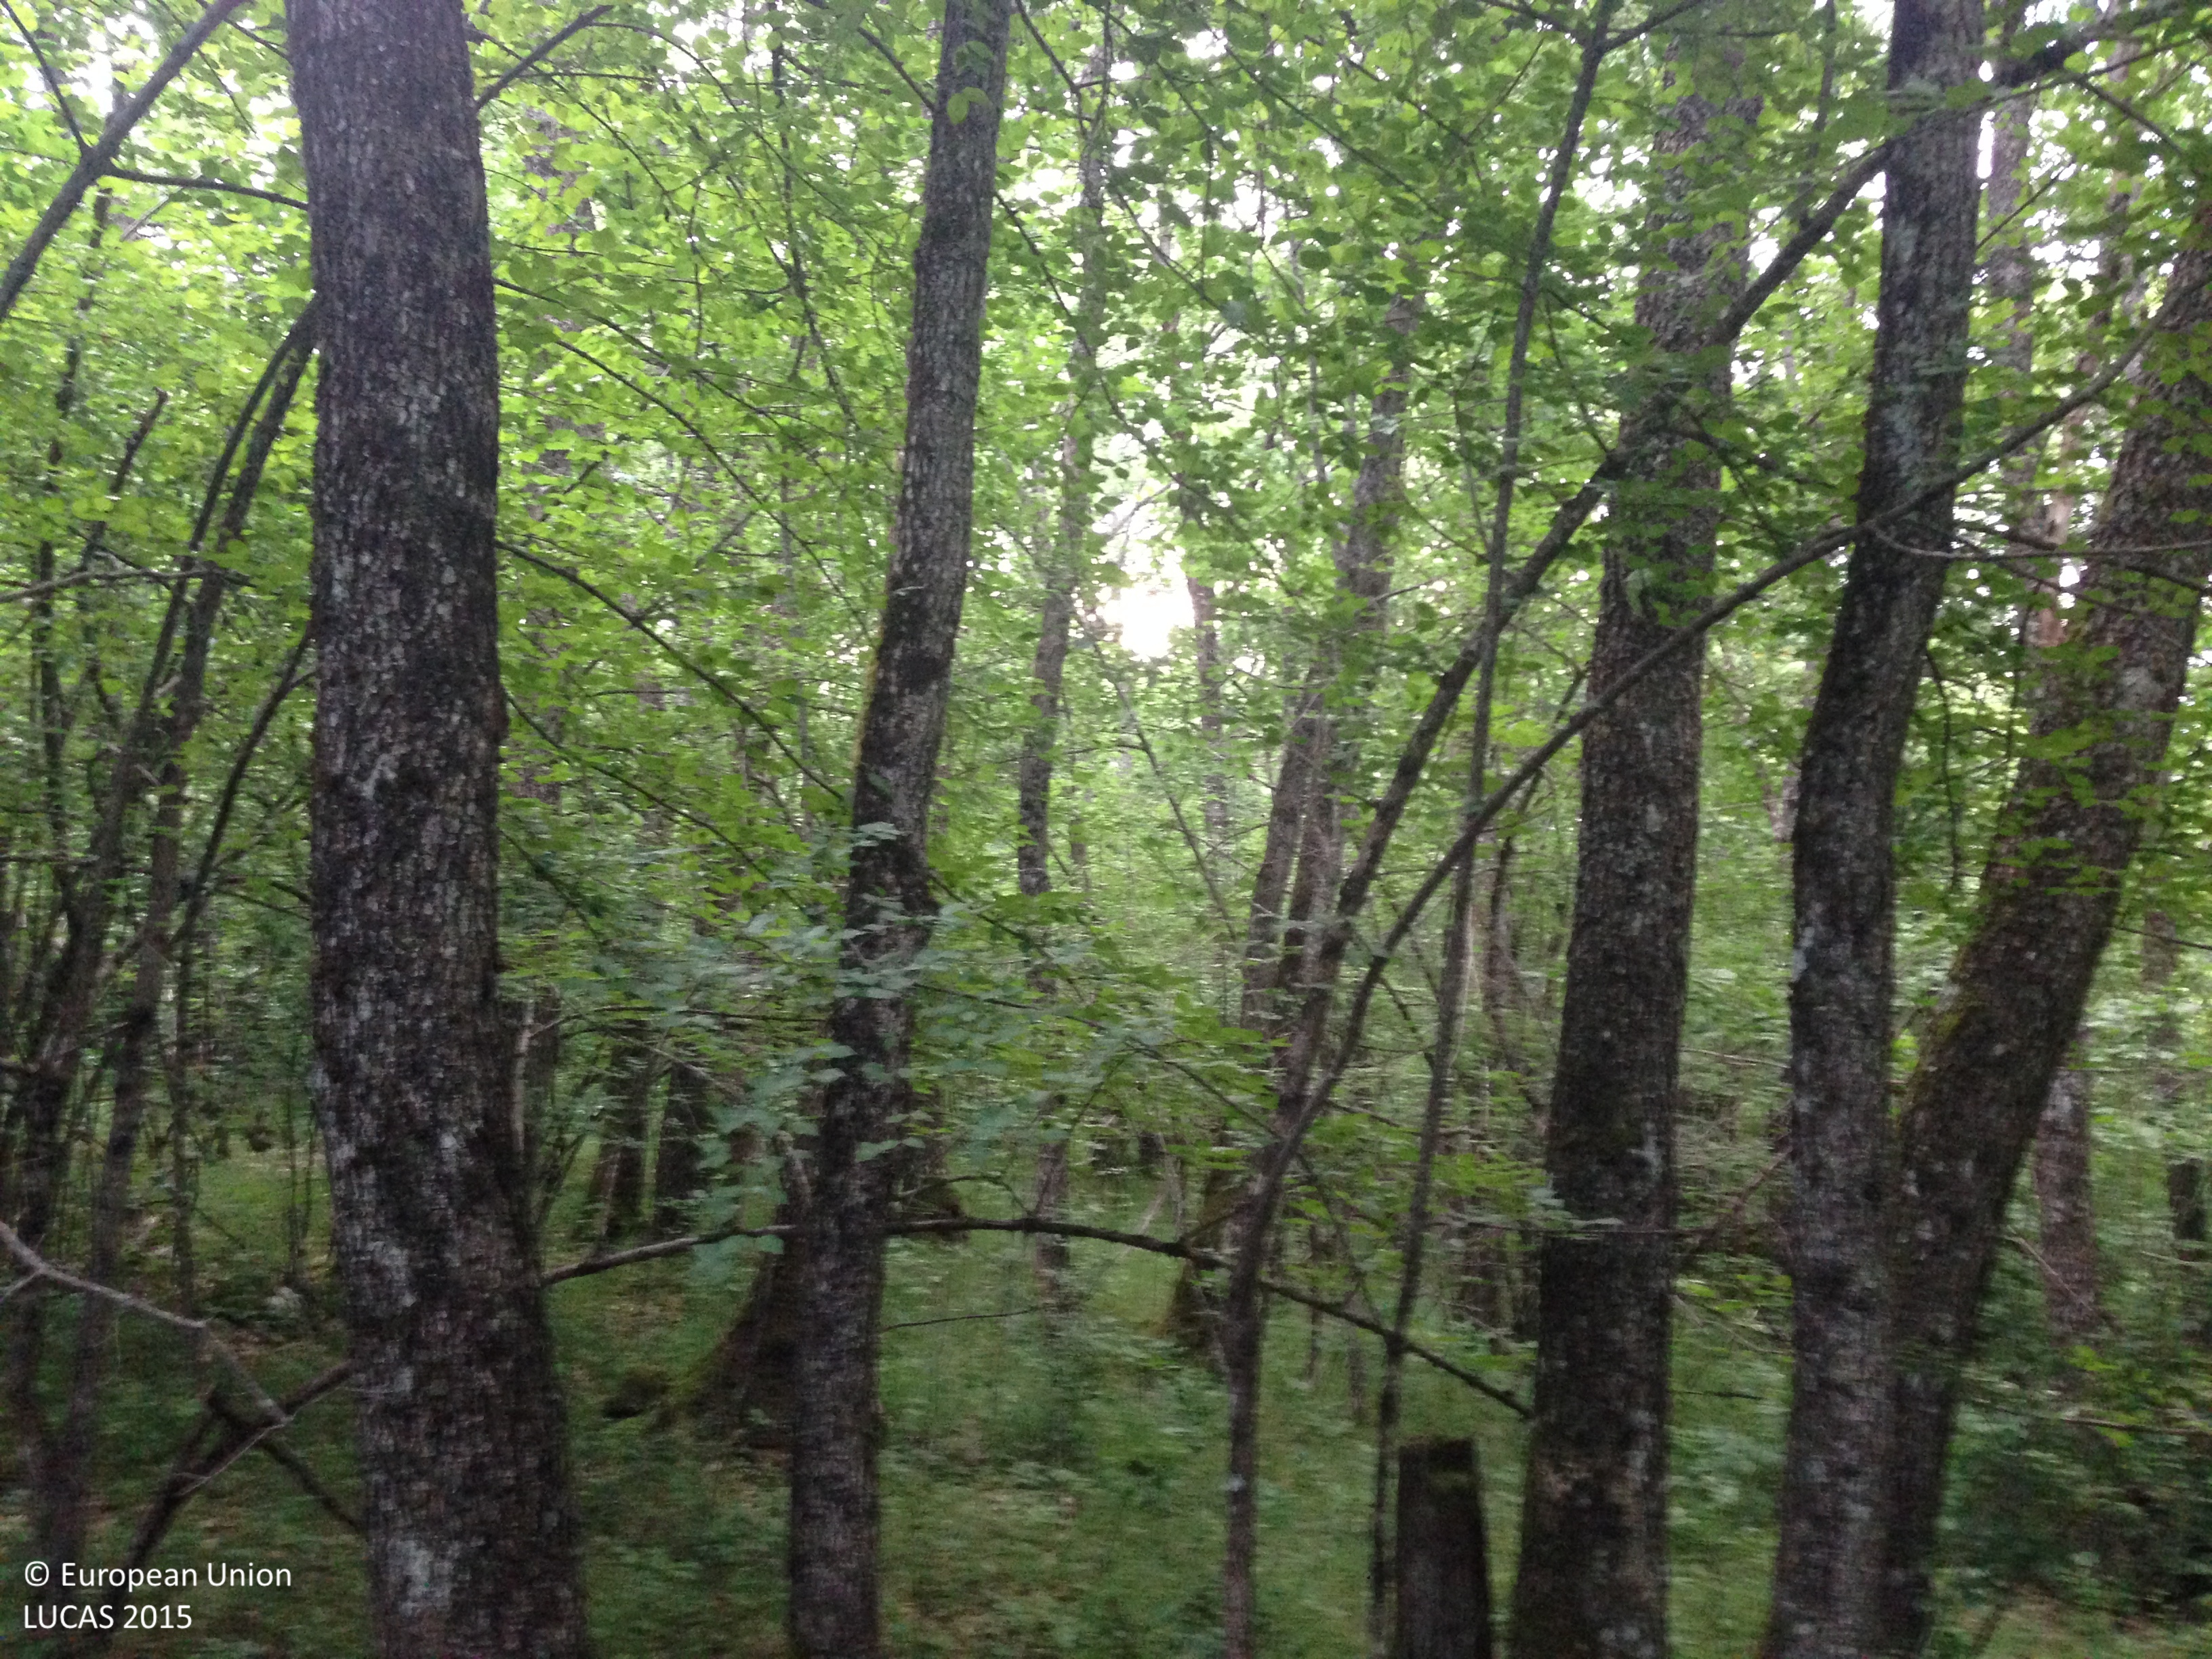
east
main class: Woodland
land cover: Broadleaved woodland
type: thermophilous deciduous forest
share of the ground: > 75 %
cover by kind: broadleaved forest trees 90 %, herbaceous plants 10 %
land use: Semi-natural and natural areas not in use
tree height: > 5 m
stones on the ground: < 10 %
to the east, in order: Broadleaved woodland
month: June
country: HR
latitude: 44.7021
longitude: 15.6608
